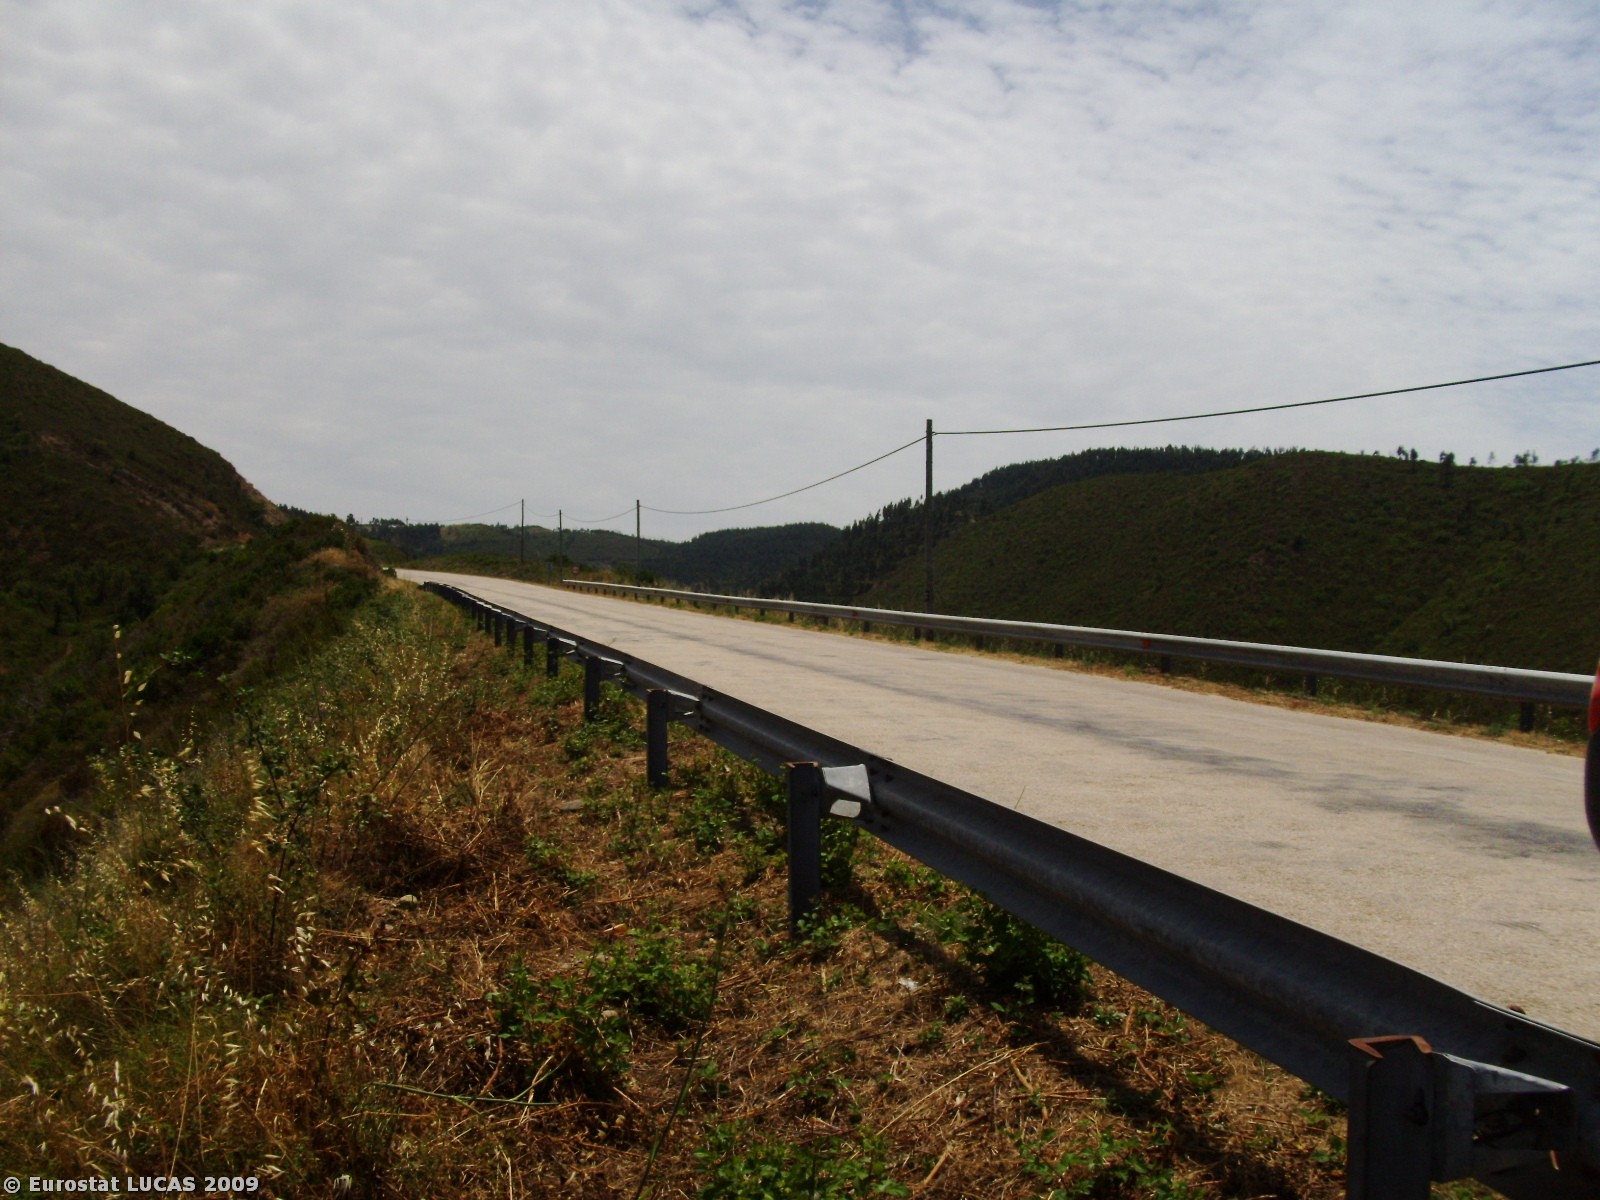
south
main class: Shrubland
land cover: Shrubland with sparse tree cover
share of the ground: > 75 %
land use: Nature reserves
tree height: < 5 m
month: June
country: PT
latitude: 37.3104
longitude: -8.7533
